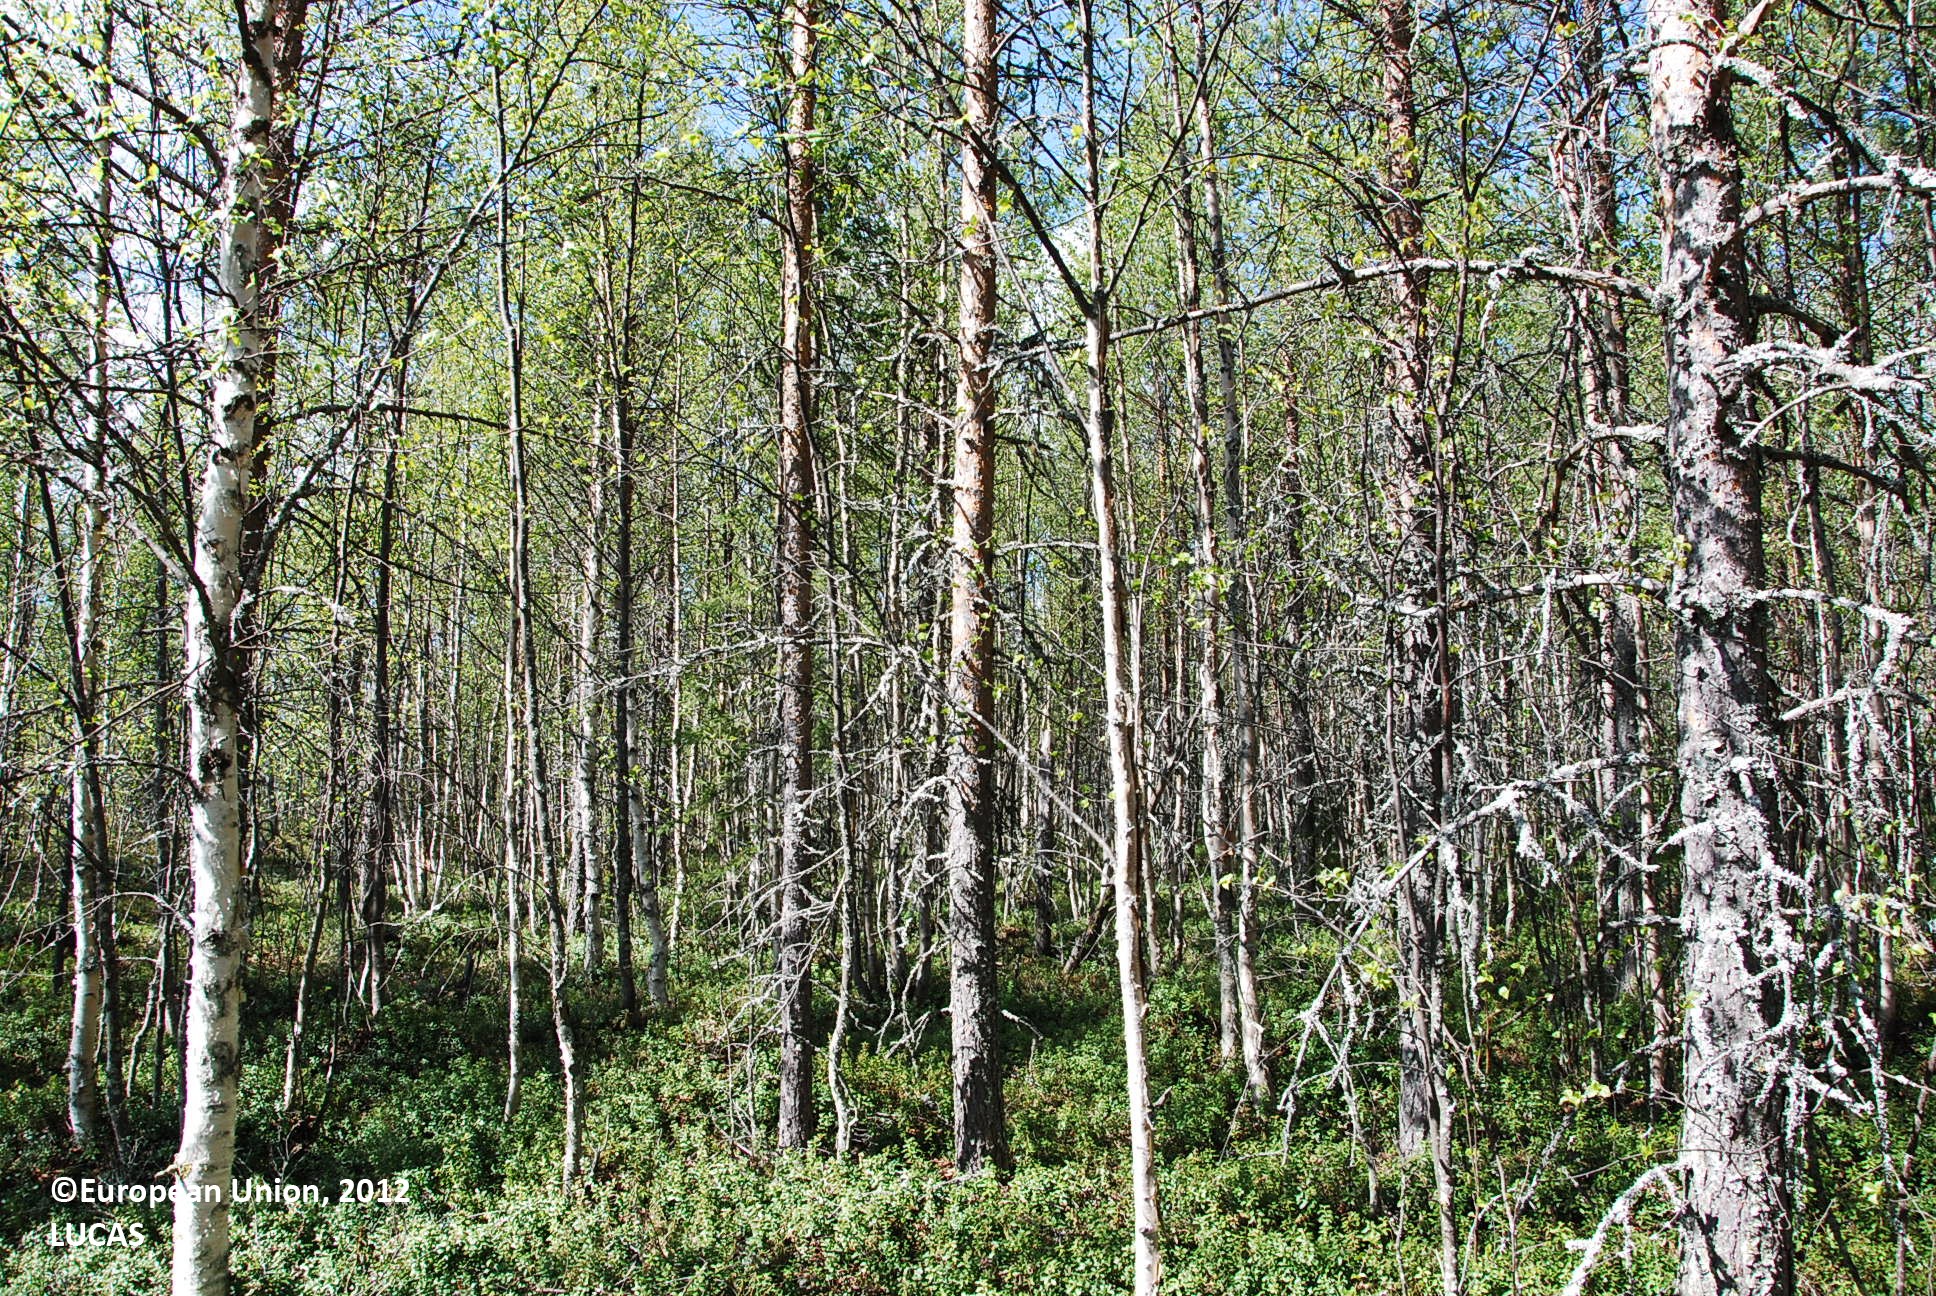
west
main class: Woodland
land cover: Pine dominated mixed woodland
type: boreal forest
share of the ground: 50 - 75 %
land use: Forestry
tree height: > 5 m
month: June
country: FI
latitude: 66.9890
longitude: 28.0734
